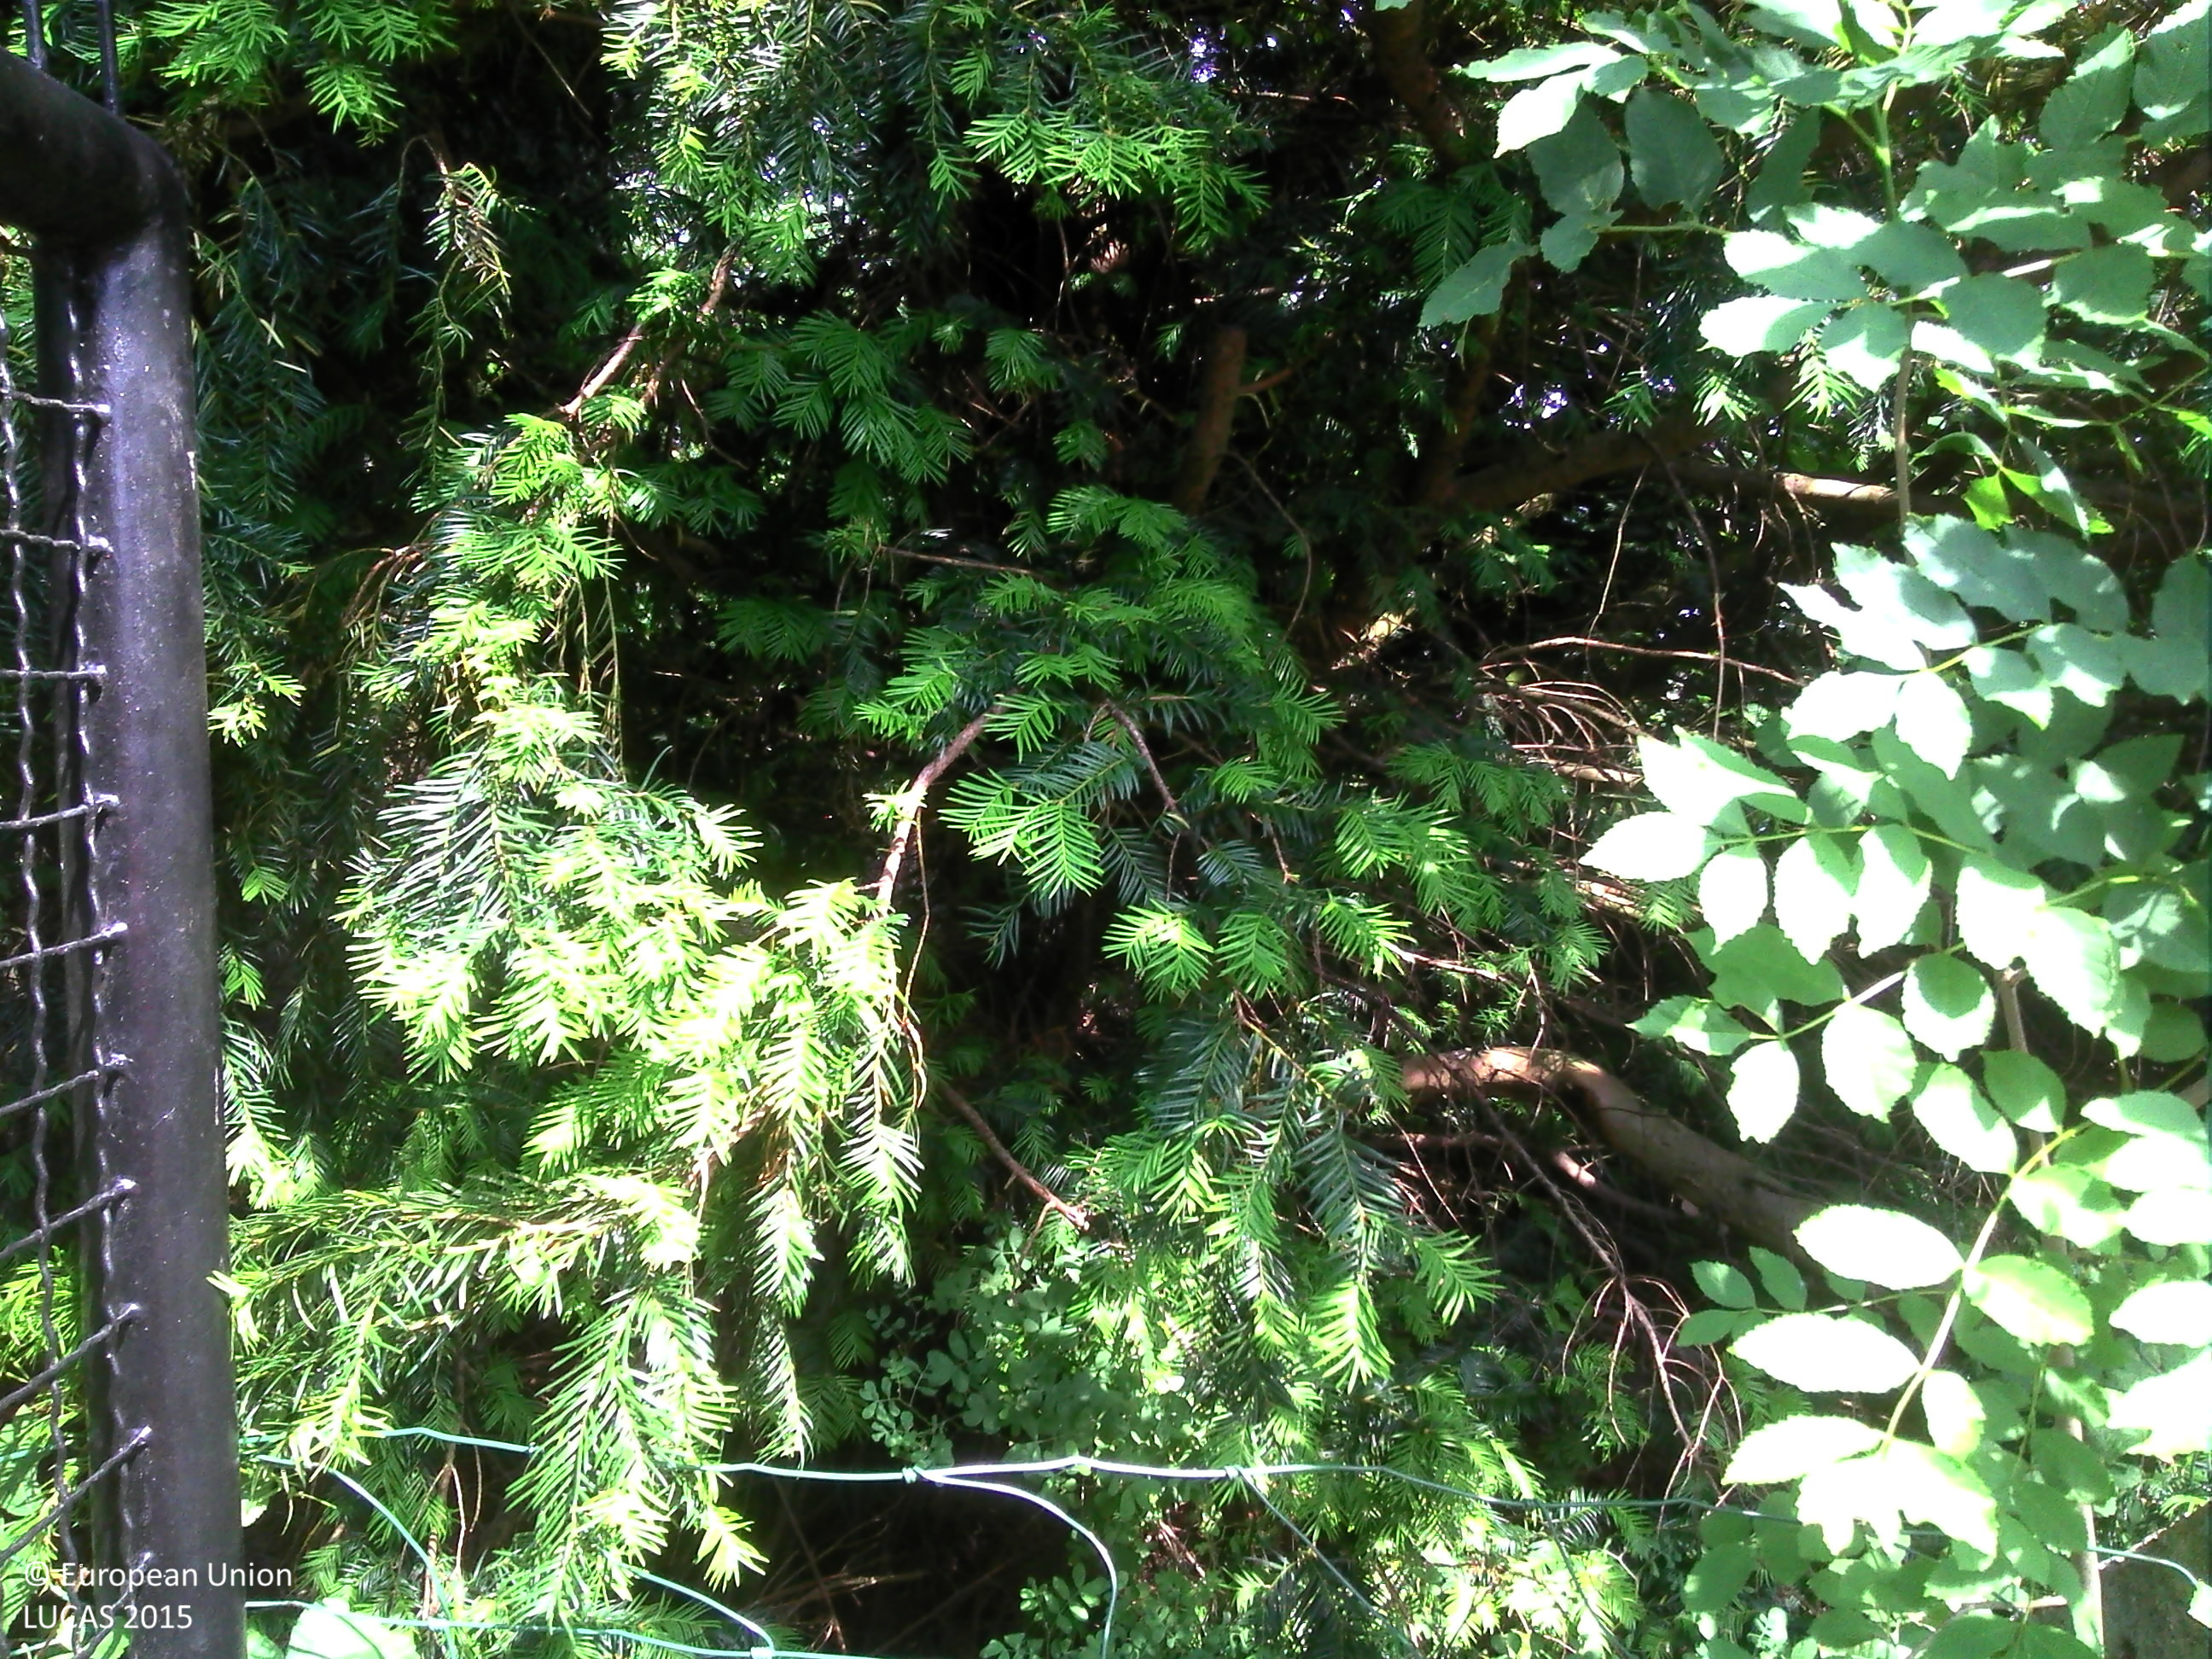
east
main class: Grassland
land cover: Grassland without tree/shrub cover
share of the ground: > 75 %
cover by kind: herbaceous plants 100 %
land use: Residential
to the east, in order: Grassland without tree/shrub cover; Artificial constructions in urban areas; Broadleaved woodland; Artificial constructions in urban areas
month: June
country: BE
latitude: 51.0554
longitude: 5.1896
